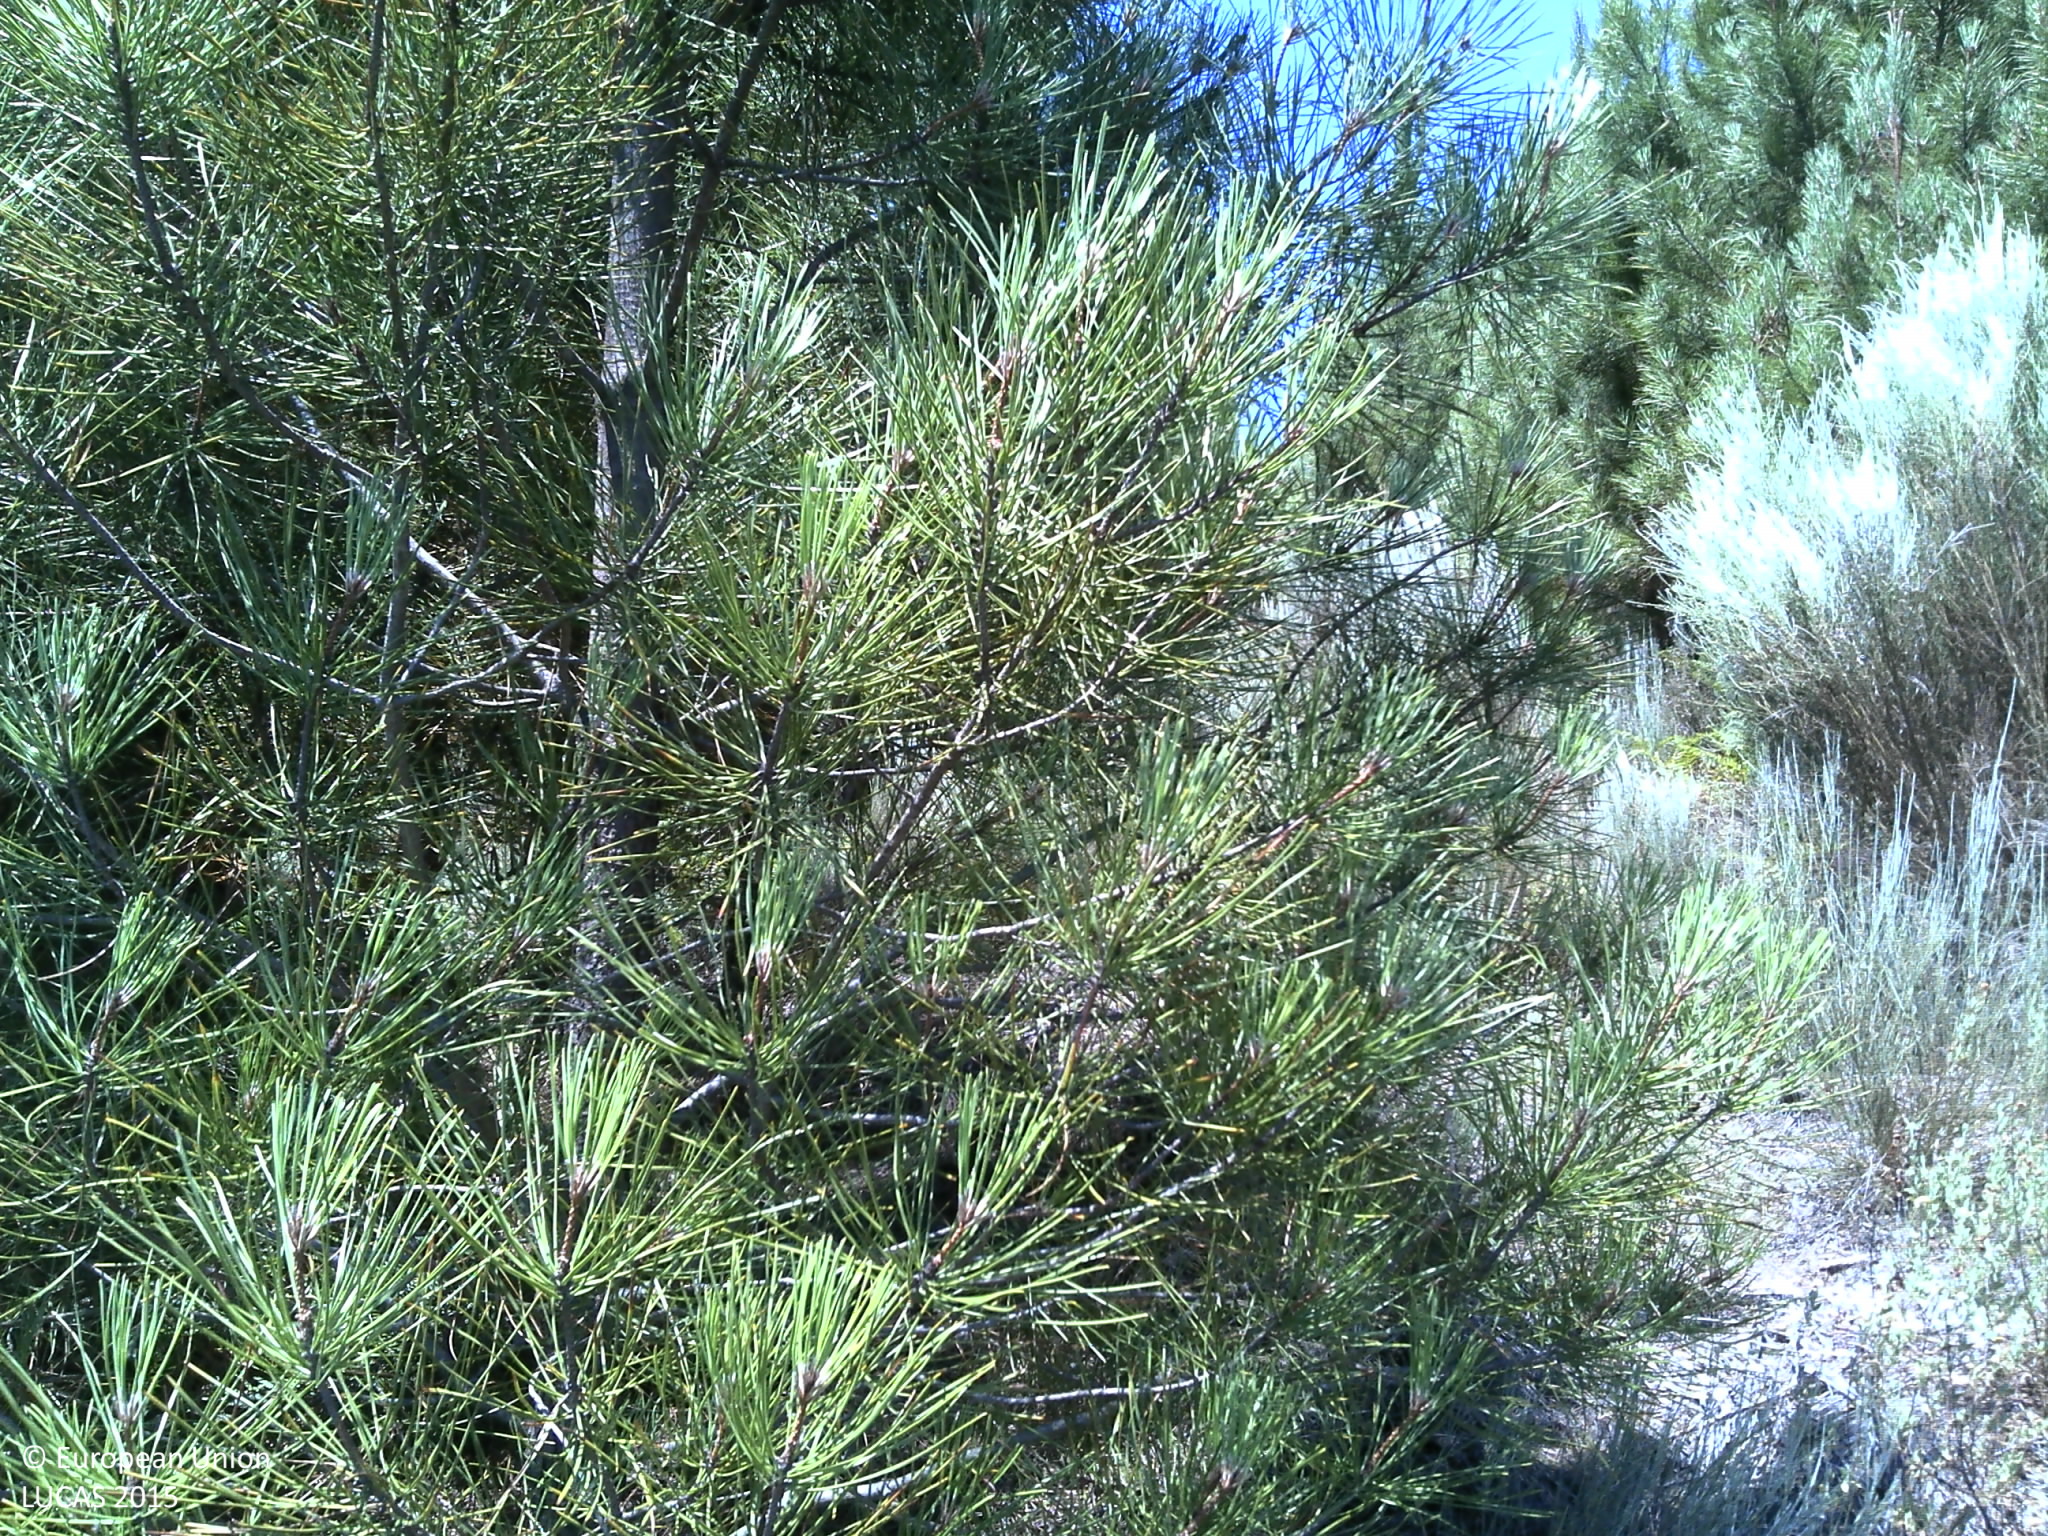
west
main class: Woodland
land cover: Pine dominated coniferous woodland
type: coniferous forest of the mediterranean region
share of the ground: 10 - 25 %
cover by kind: shrubs 80 %, coniferous forest trees 15 %, consolidated bare surface 5 %
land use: Forestry
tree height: < 5 m
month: July
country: PT
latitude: 40.7720
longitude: -7.5690
